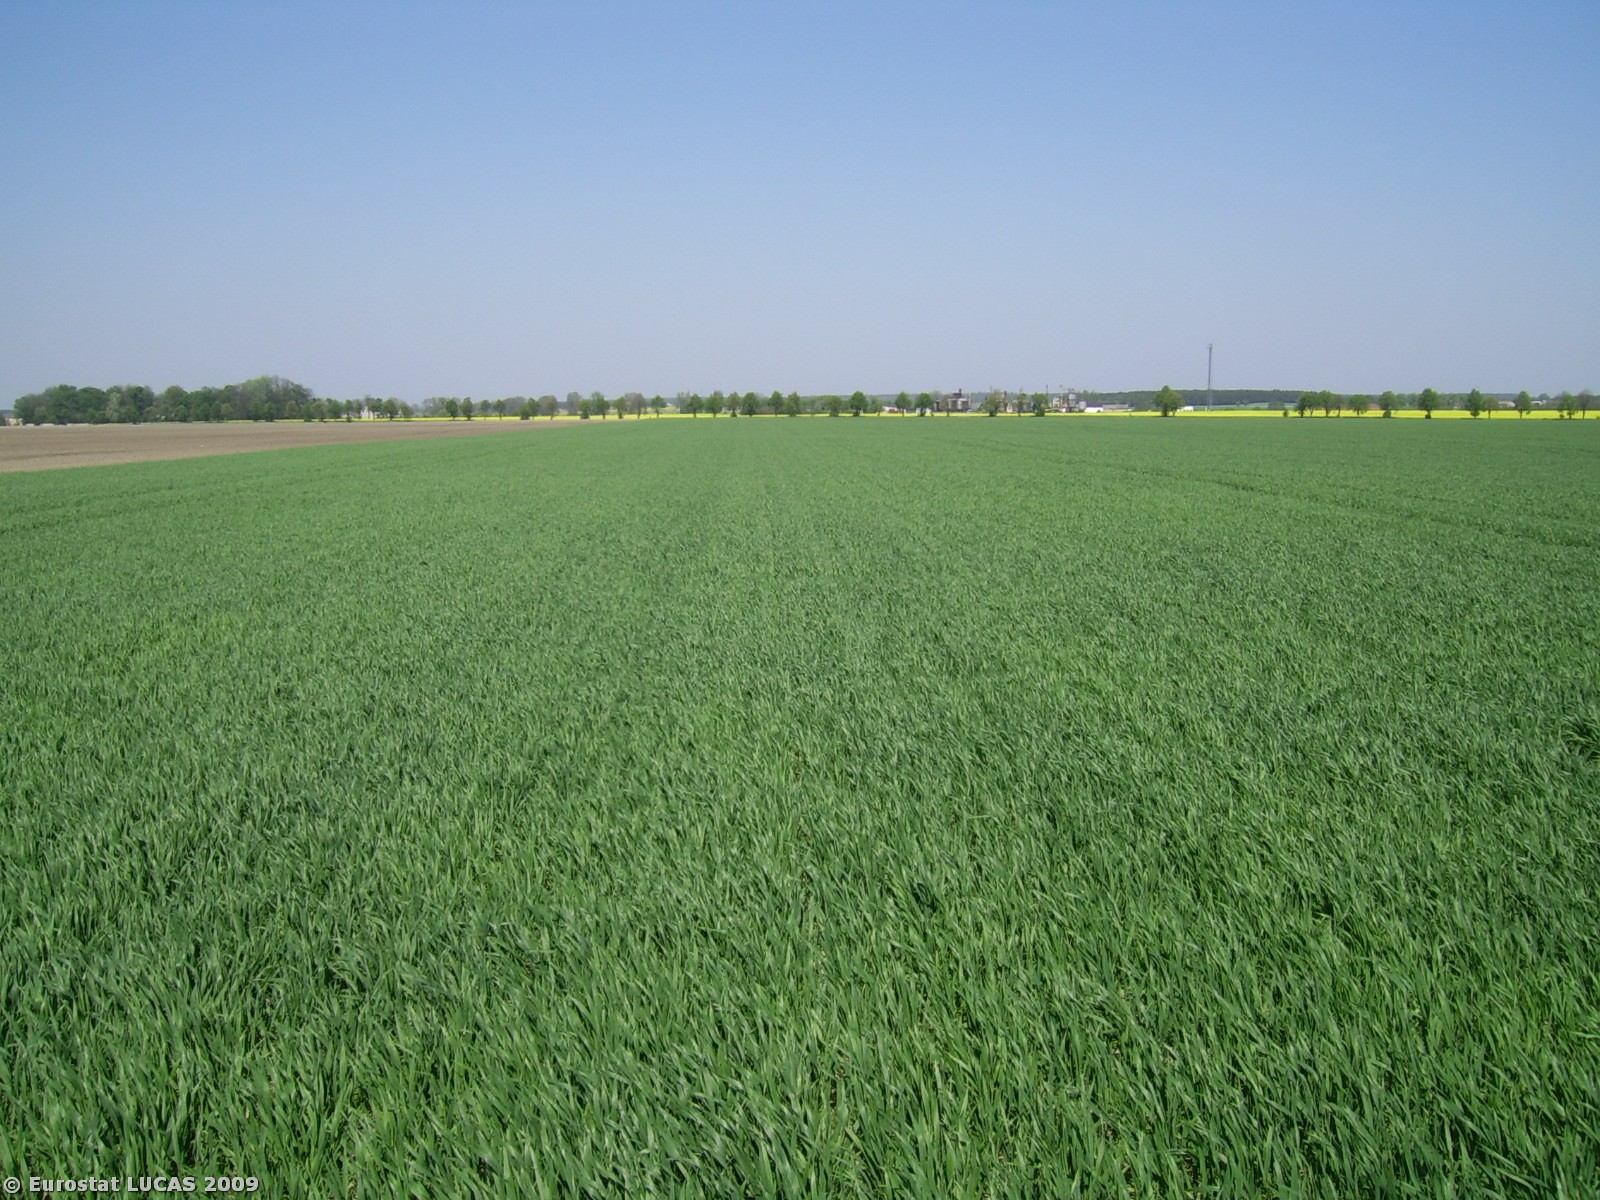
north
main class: Cropland
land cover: Rye
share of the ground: > 75 %
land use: Agriculture (excluding fallow land and kitchen gardens)
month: April
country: PL
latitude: 52.1053
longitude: 16.8861
